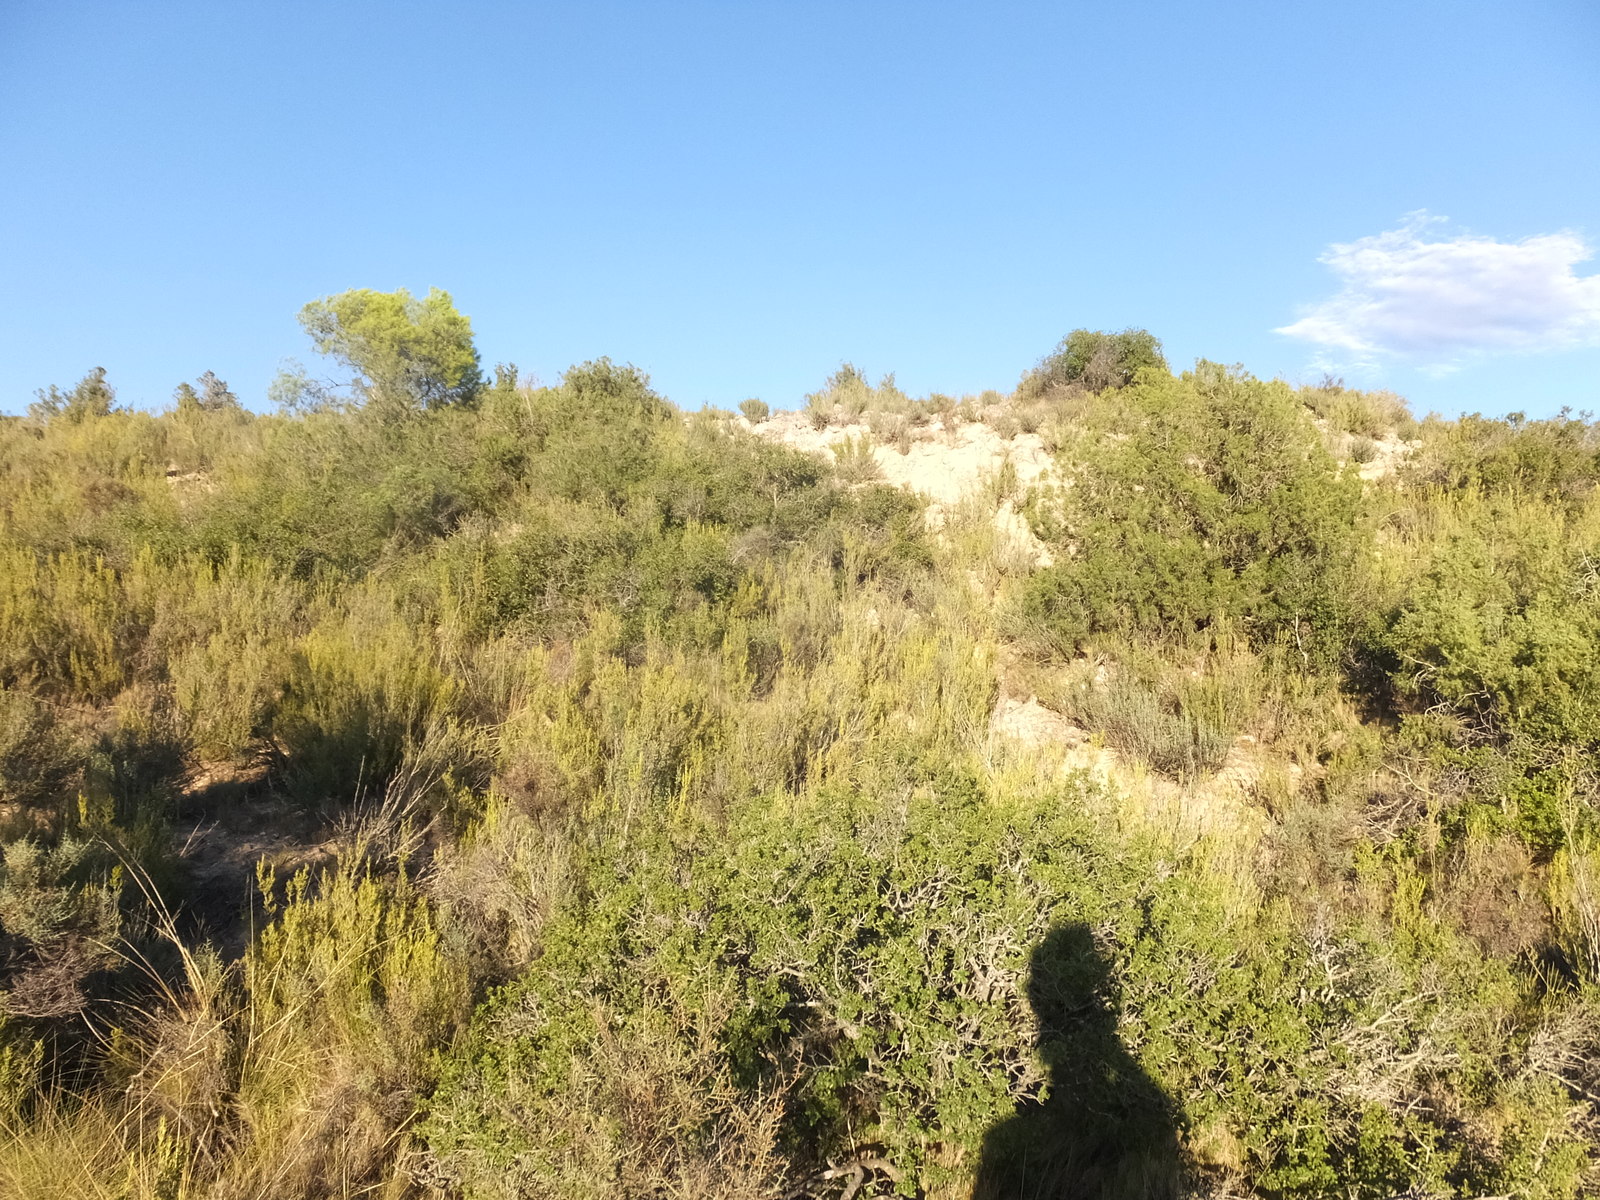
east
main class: Shrubland
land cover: Shrubland with sparse tree cover
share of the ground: > 75 %
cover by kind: shrubs 50 %, herbaceous plants 45 %, coniferous forest trees 5 %
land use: Semi-natural and natural areas not in use
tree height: < 5 m
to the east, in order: Shrubland with sparse tree cover; Olive groves; Shruby margins; Nuts trees; Shruby margins; Tracks; Shrubland without tree cover
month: August
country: ES
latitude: 41.3209
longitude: 0.1797
